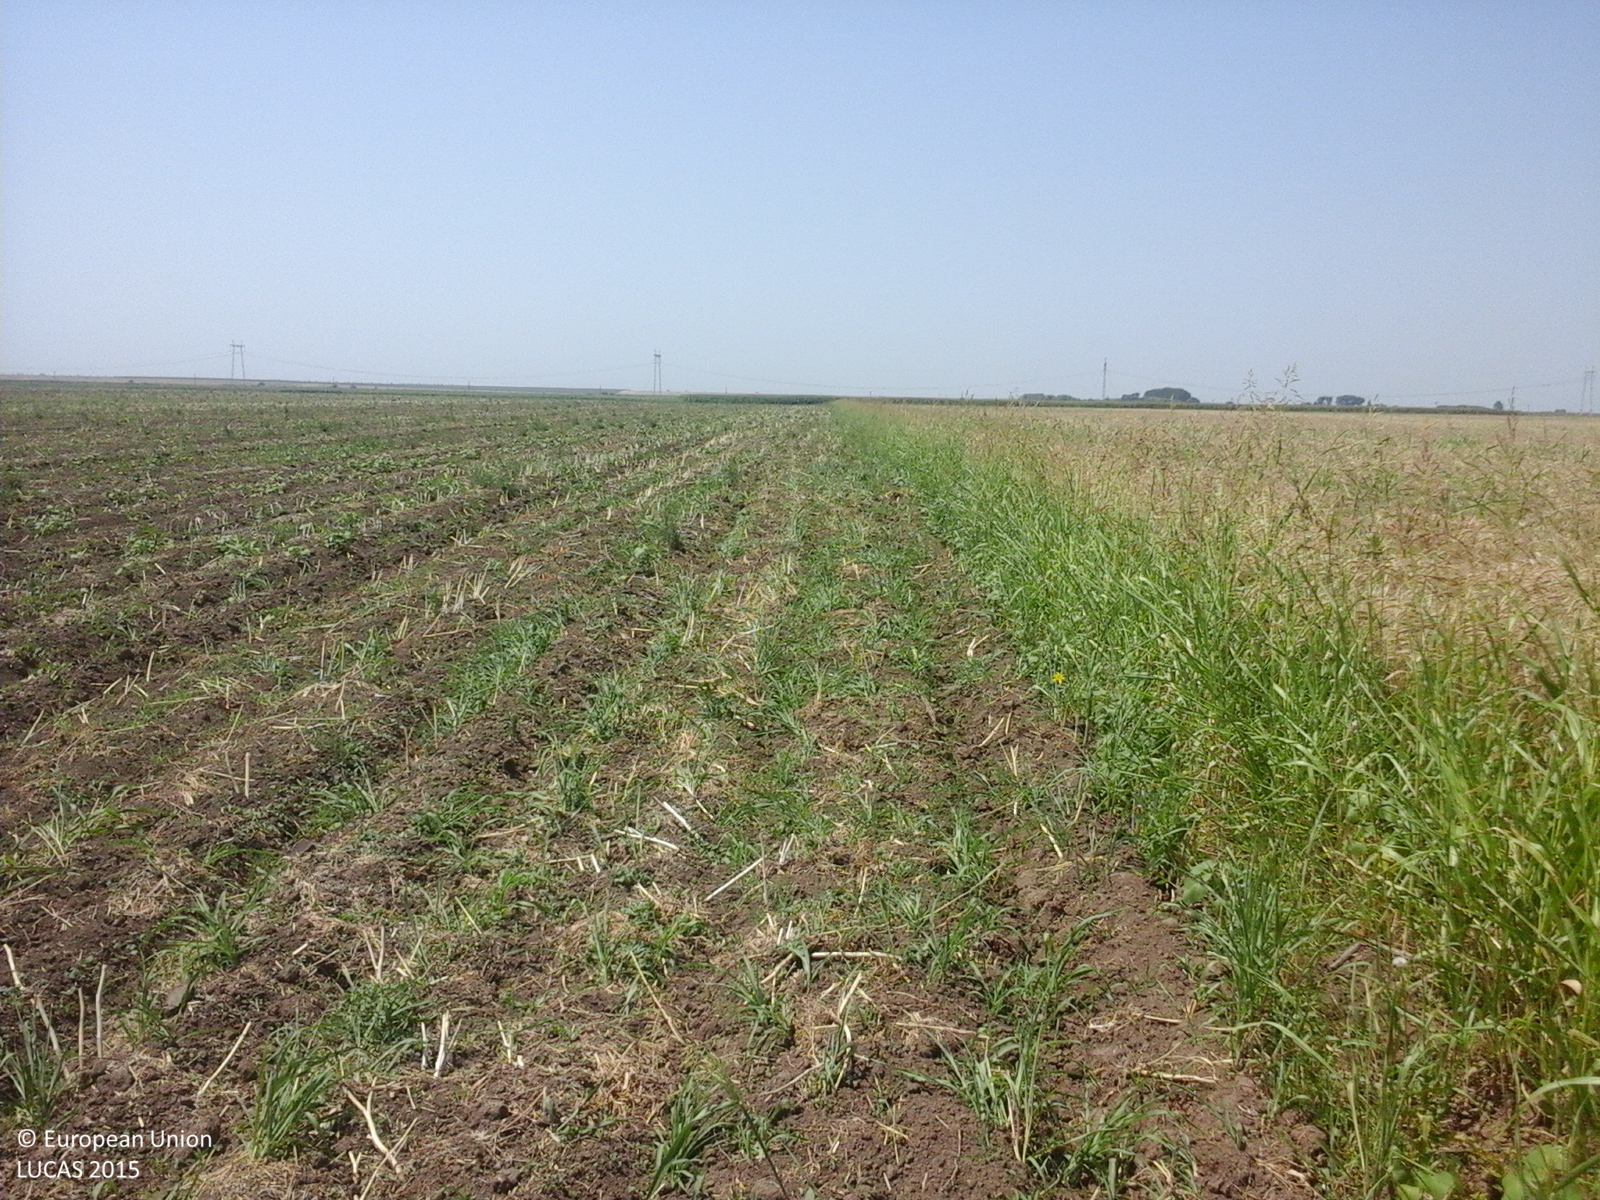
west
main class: Cropland
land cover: Common wheat
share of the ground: > 75 %
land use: Agriculture (excluding fallow land and kitchen gardens)
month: July
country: RO
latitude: 44.7367
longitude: 27.6657
